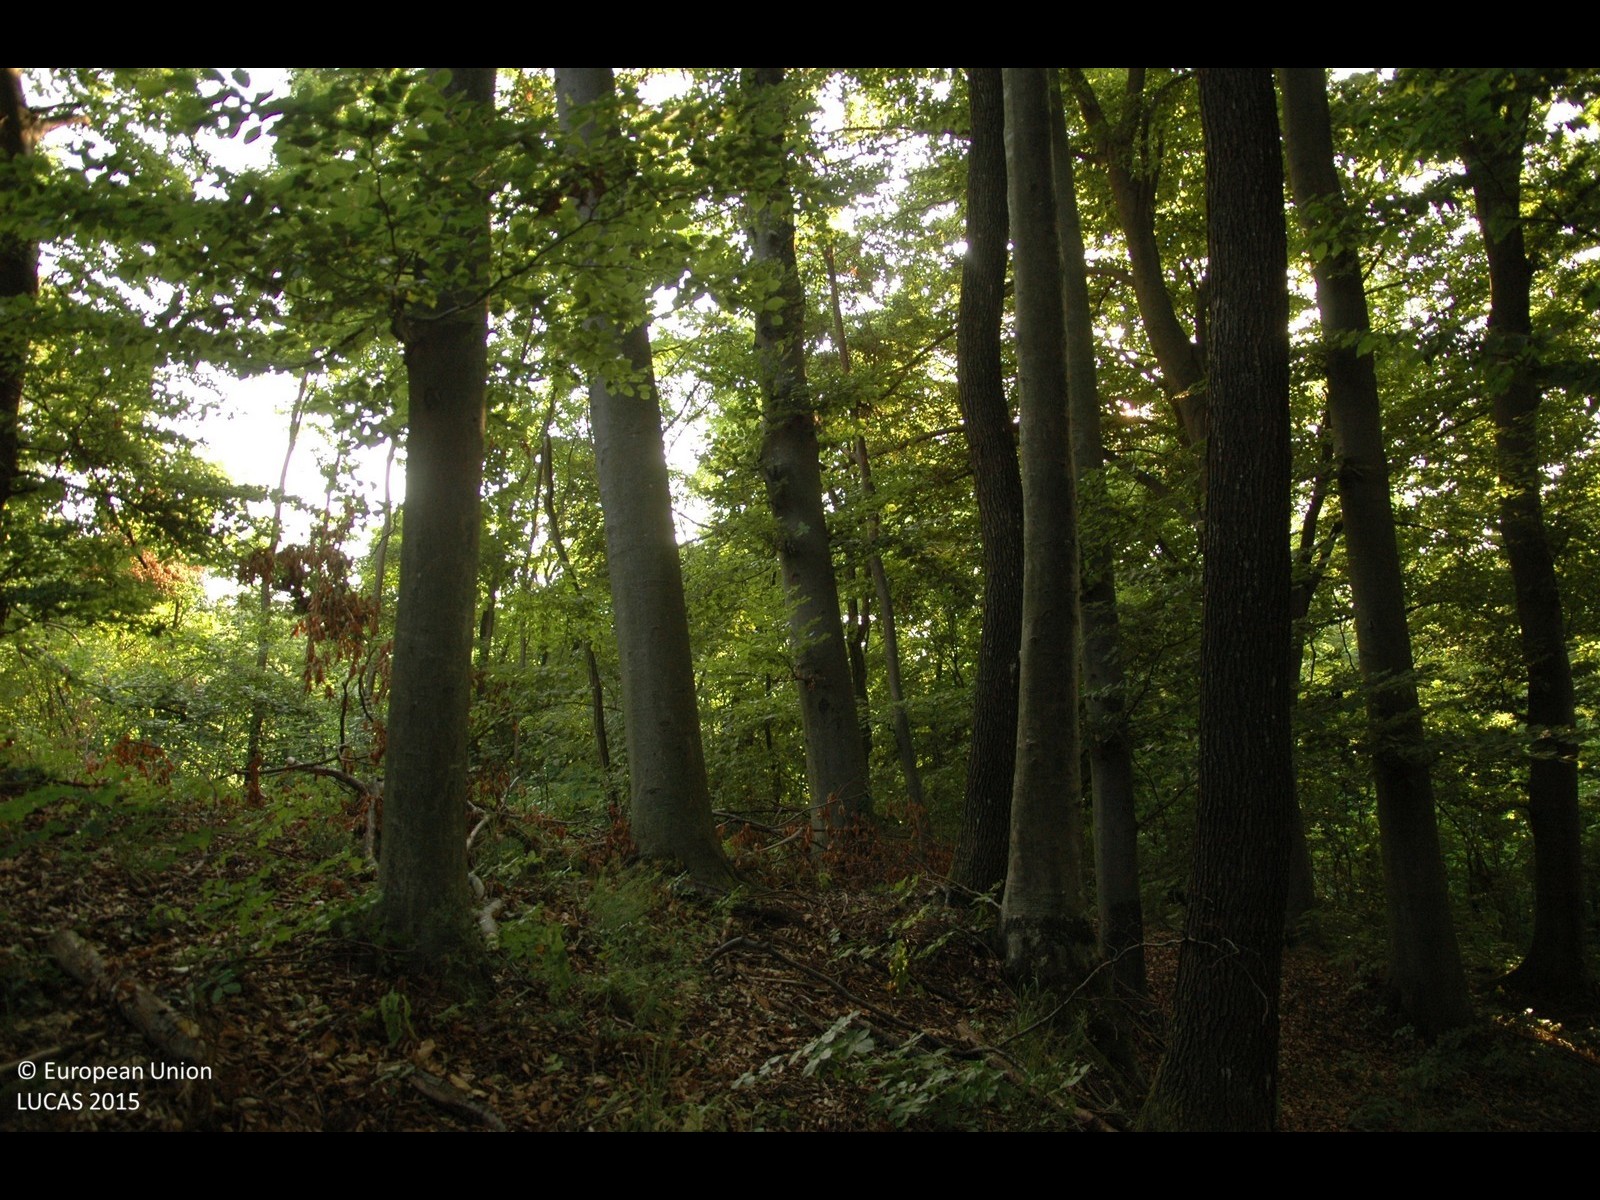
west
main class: Woodland
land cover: Broadleaved woodland
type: beech forest
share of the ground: > 75 %
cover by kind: broadleaved forest trees 100 %
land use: Forestry
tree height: > 5 m
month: July
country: HR
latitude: 46.0199
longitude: 16.0050
